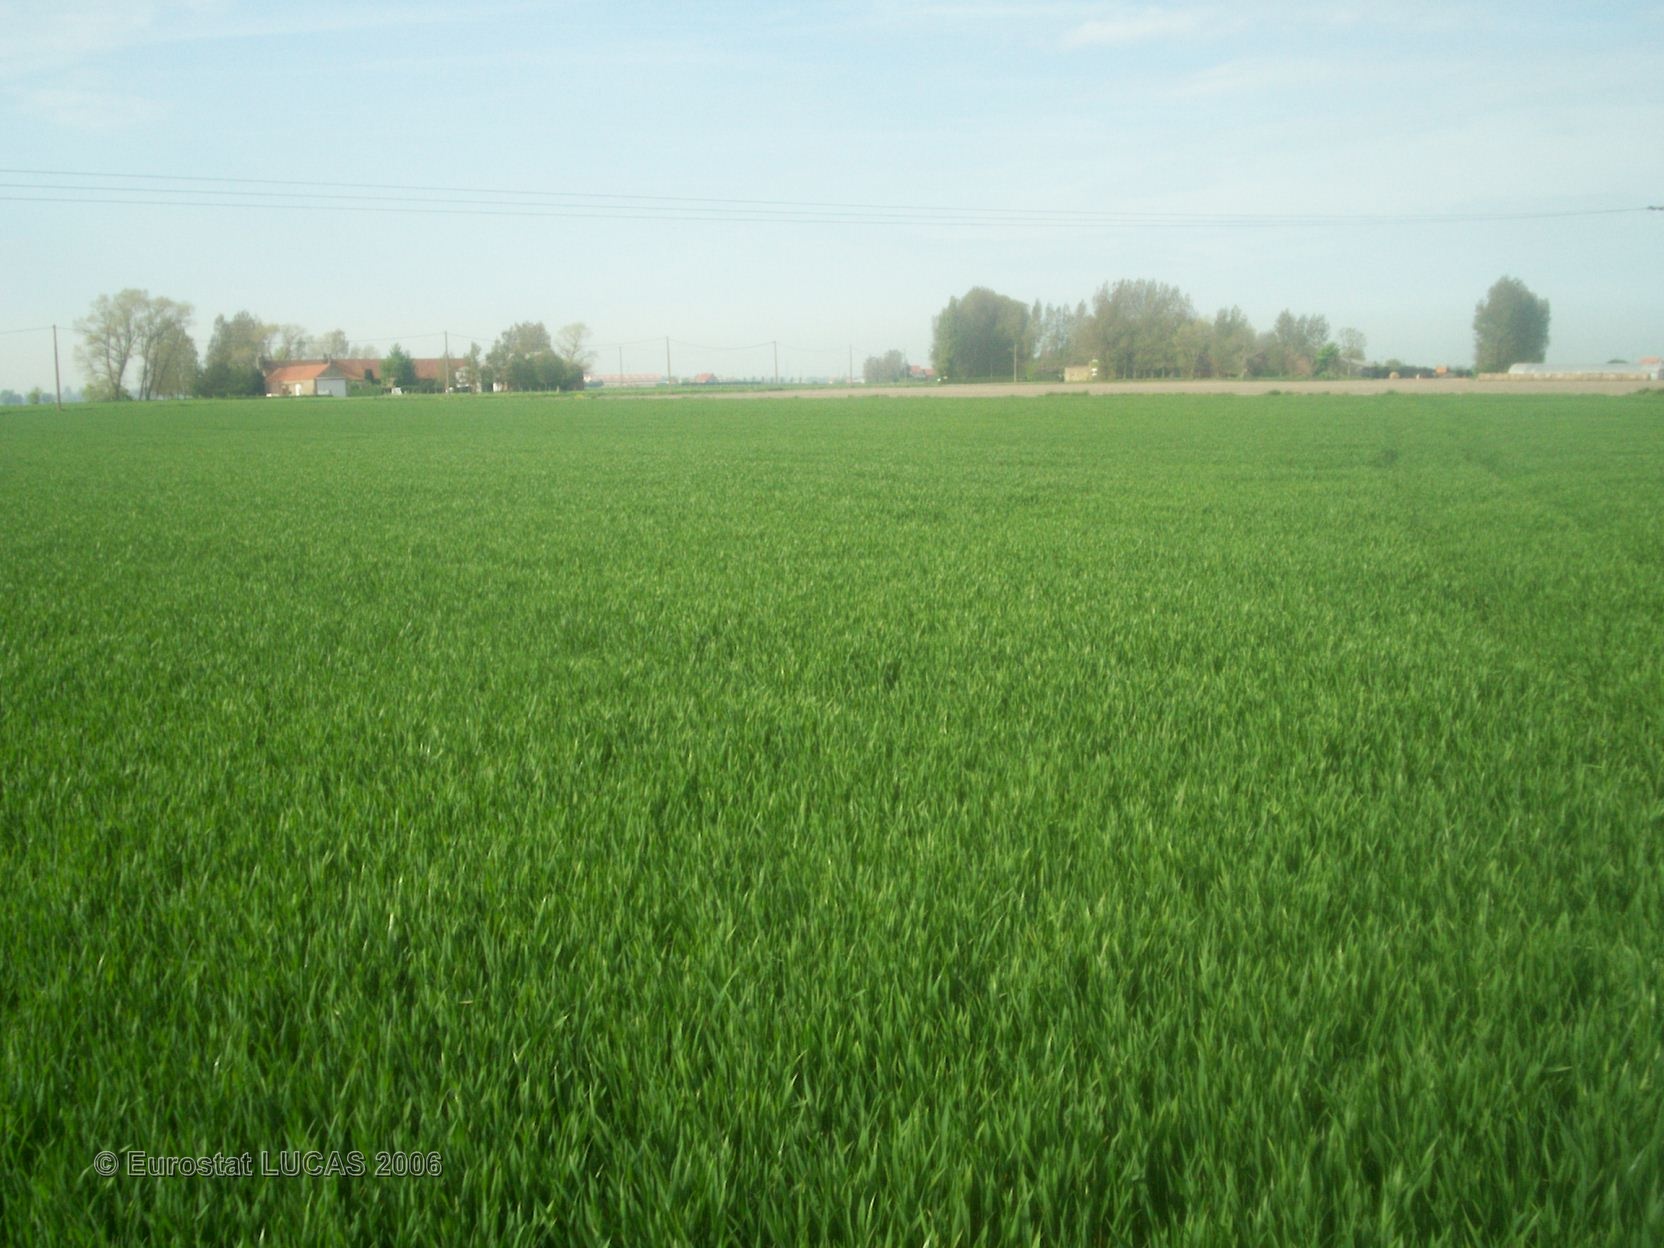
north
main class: Cropland
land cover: Common wheat
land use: Agriculture (excluding fallow land and kitchen gardens)
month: May
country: FR
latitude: 50.9813
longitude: 2.4519
